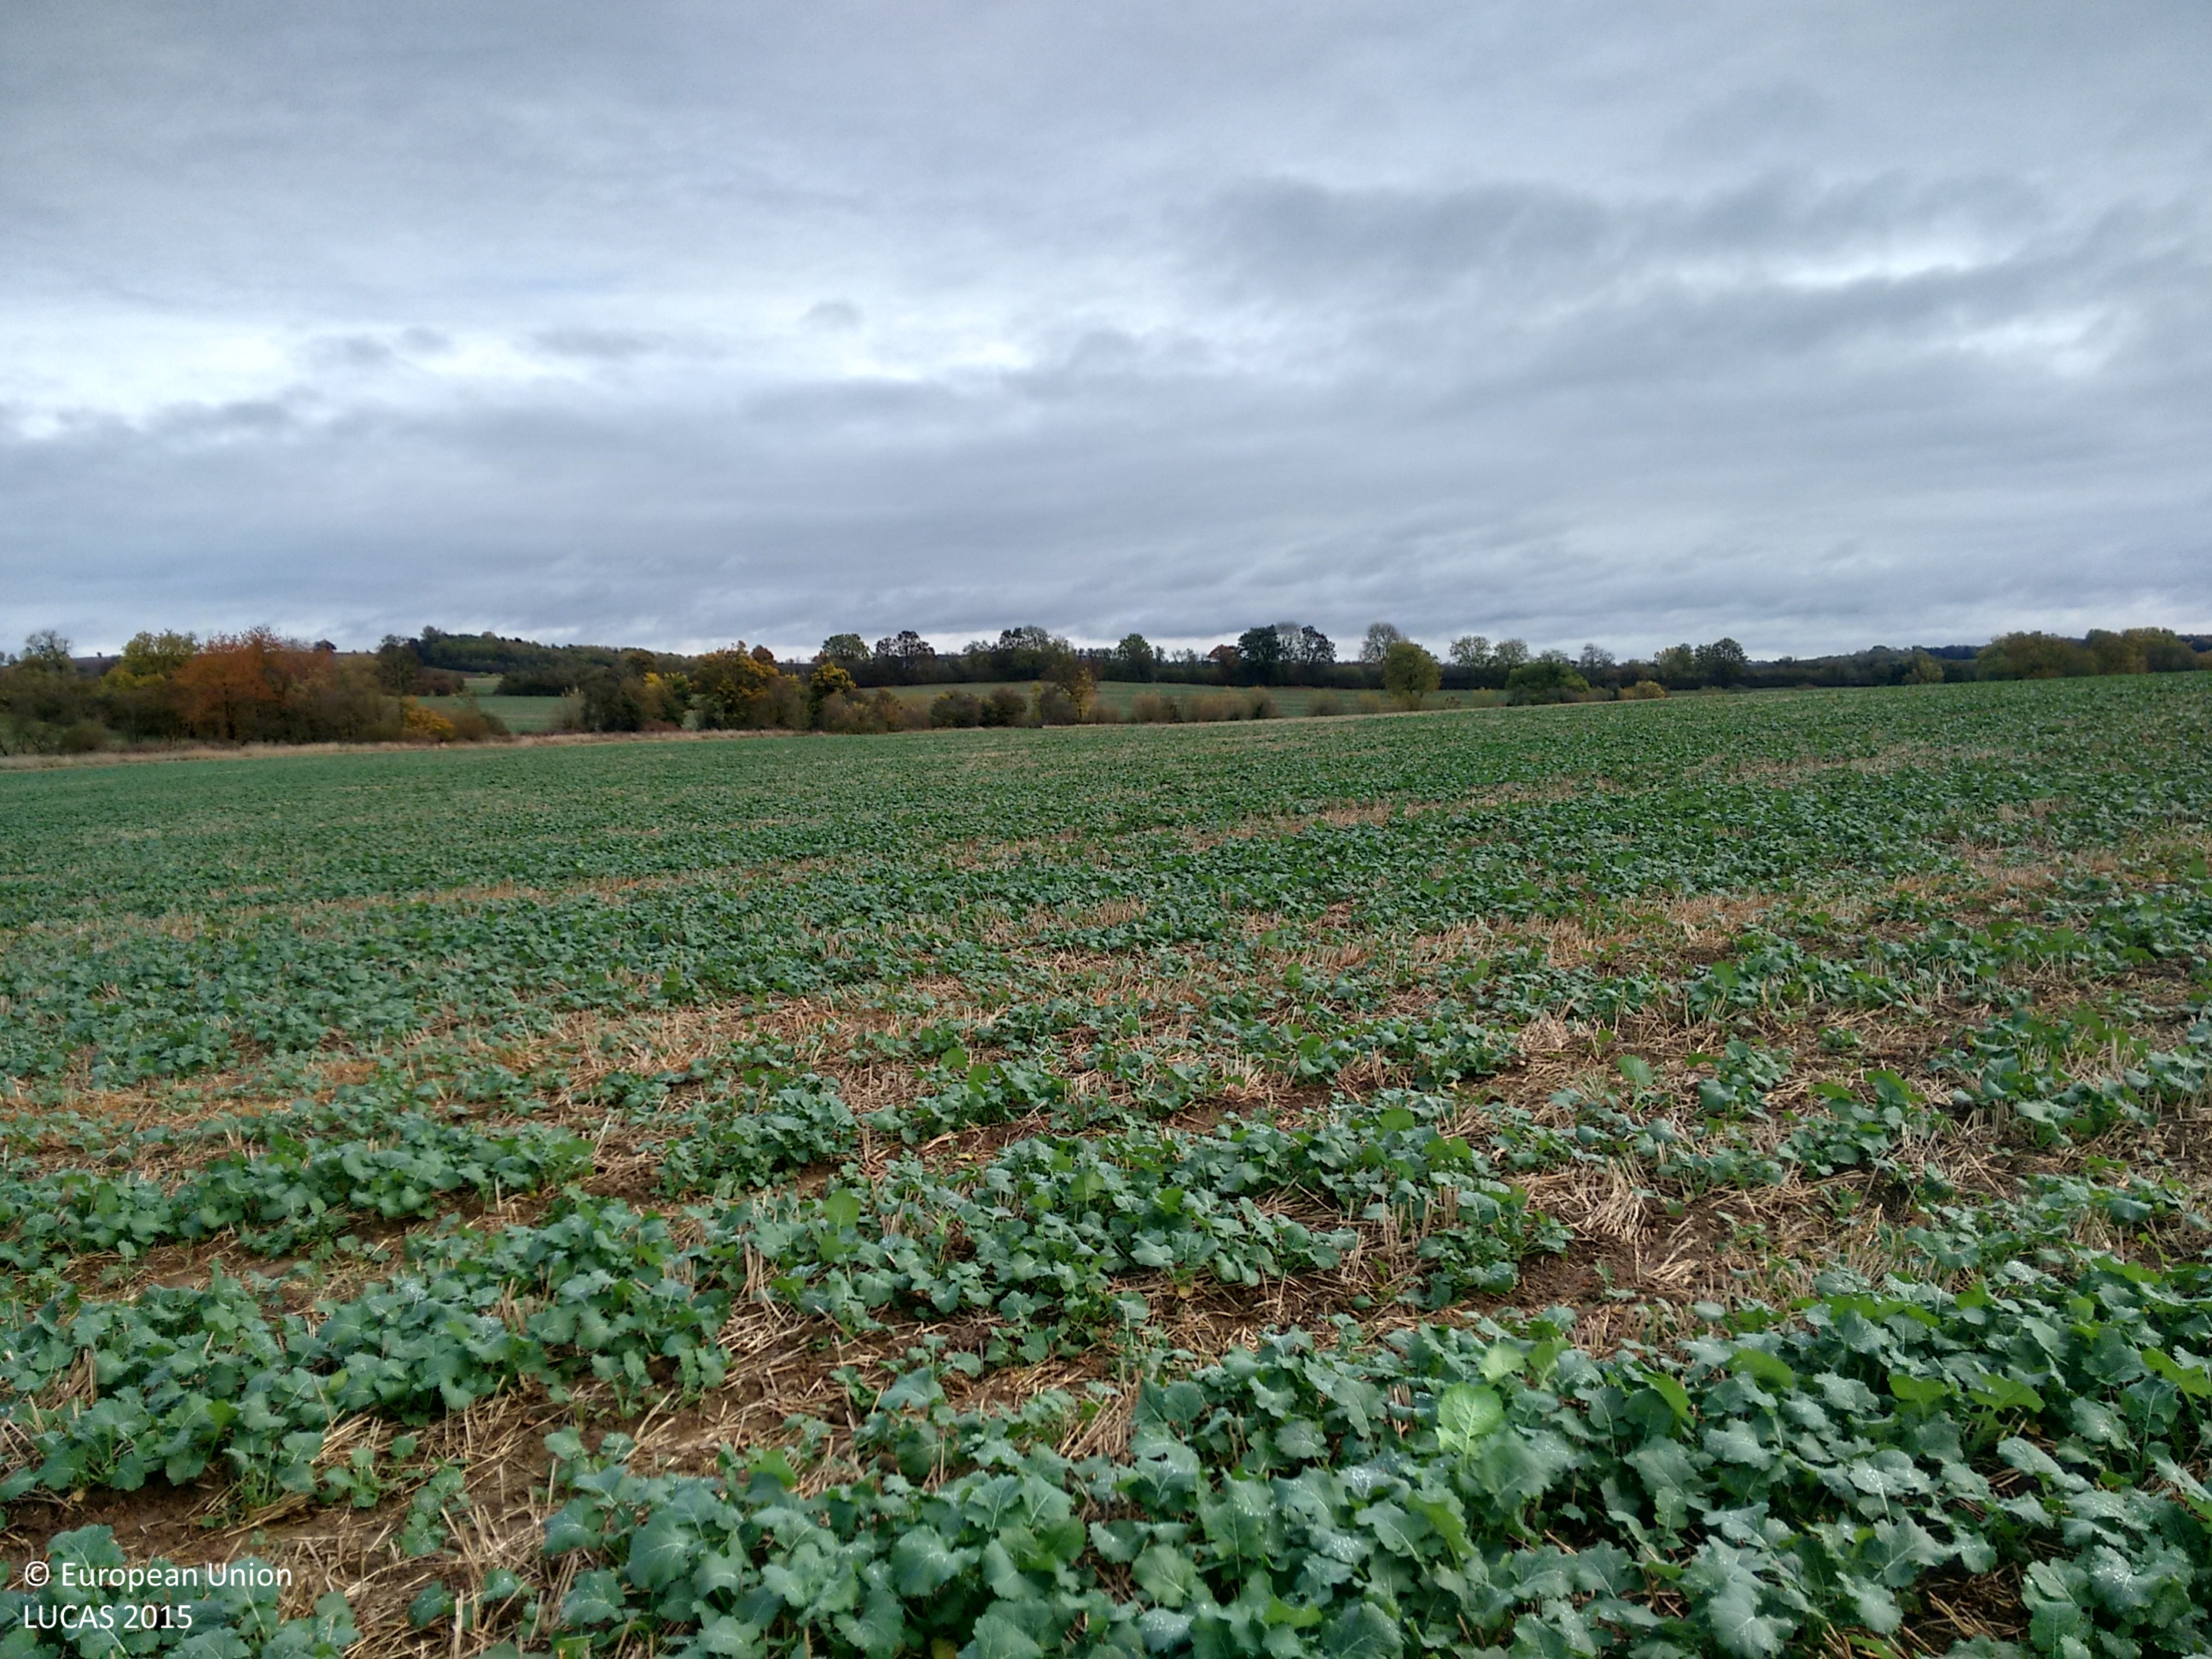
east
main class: Cropland
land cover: Rape and turnip rape
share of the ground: 50 - 75 %
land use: Agriculture (excluding fallow land and kitchen gardens)
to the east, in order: Rape and turnip rape
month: October
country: GB
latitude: 52.0356
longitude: -1.6718
